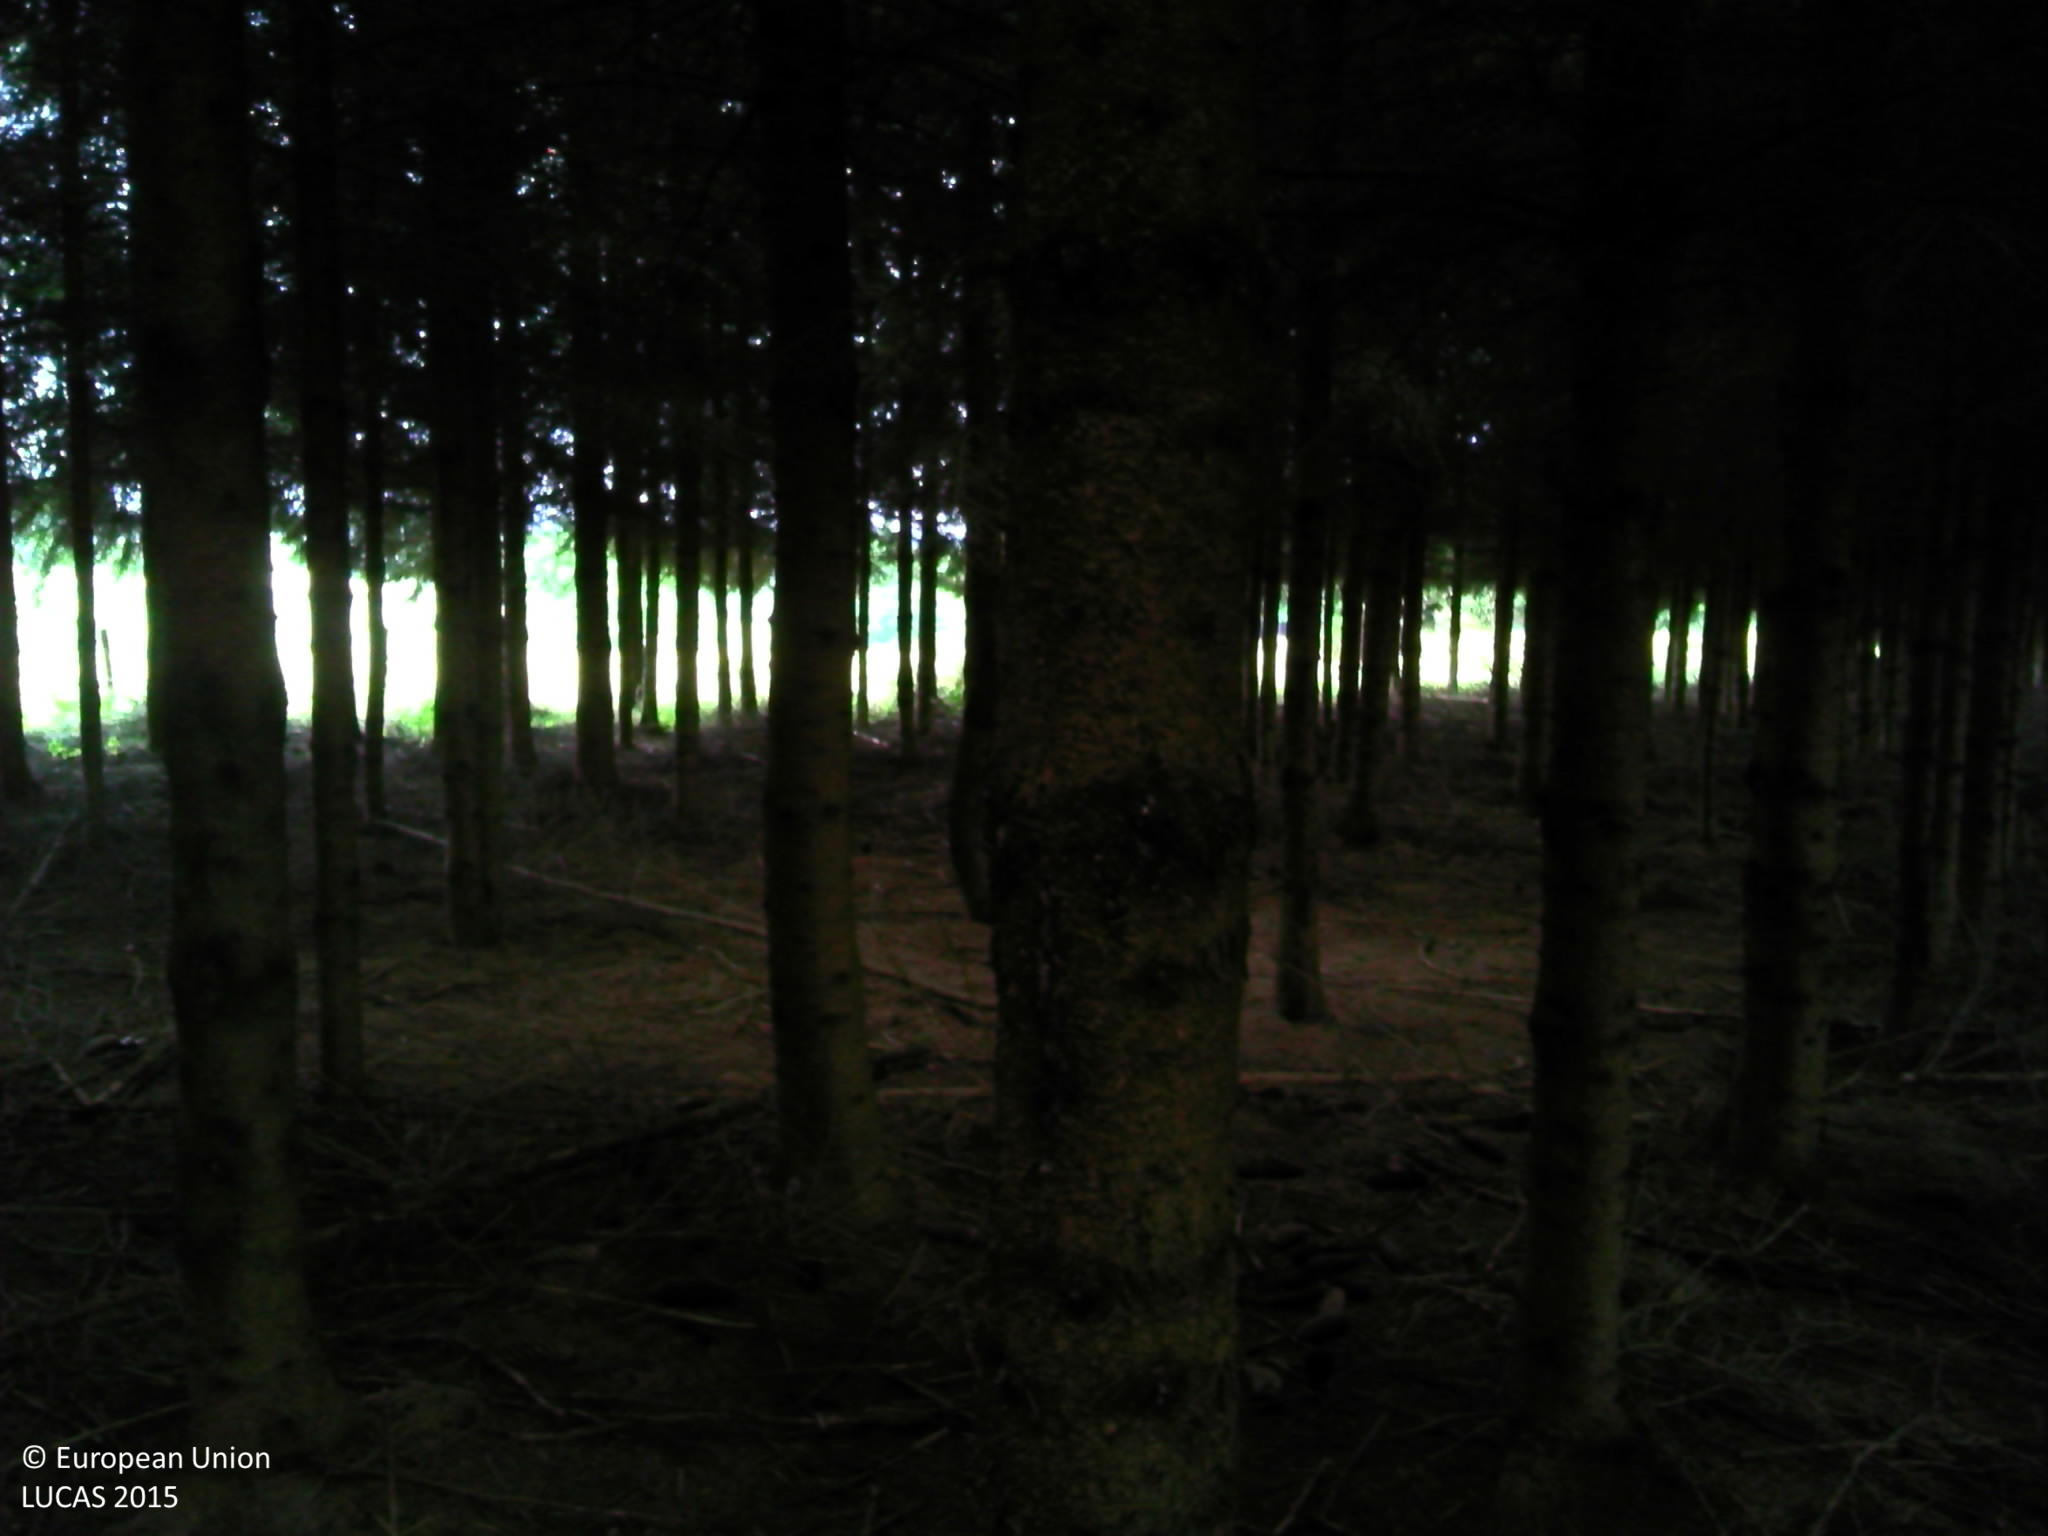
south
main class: Woodland
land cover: Spruce dominated coniferous woodland
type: hemiboreal forest and nemoral coniferous forest and mixed broadleaved-coniferous forest
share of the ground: > 75 %
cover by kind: coniferous forest trees 95 %, unconsolidated bare surface 5 %
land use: Forestry
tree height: > 5 m
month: July
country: BE
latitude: 50.1824
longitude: 5.8957
